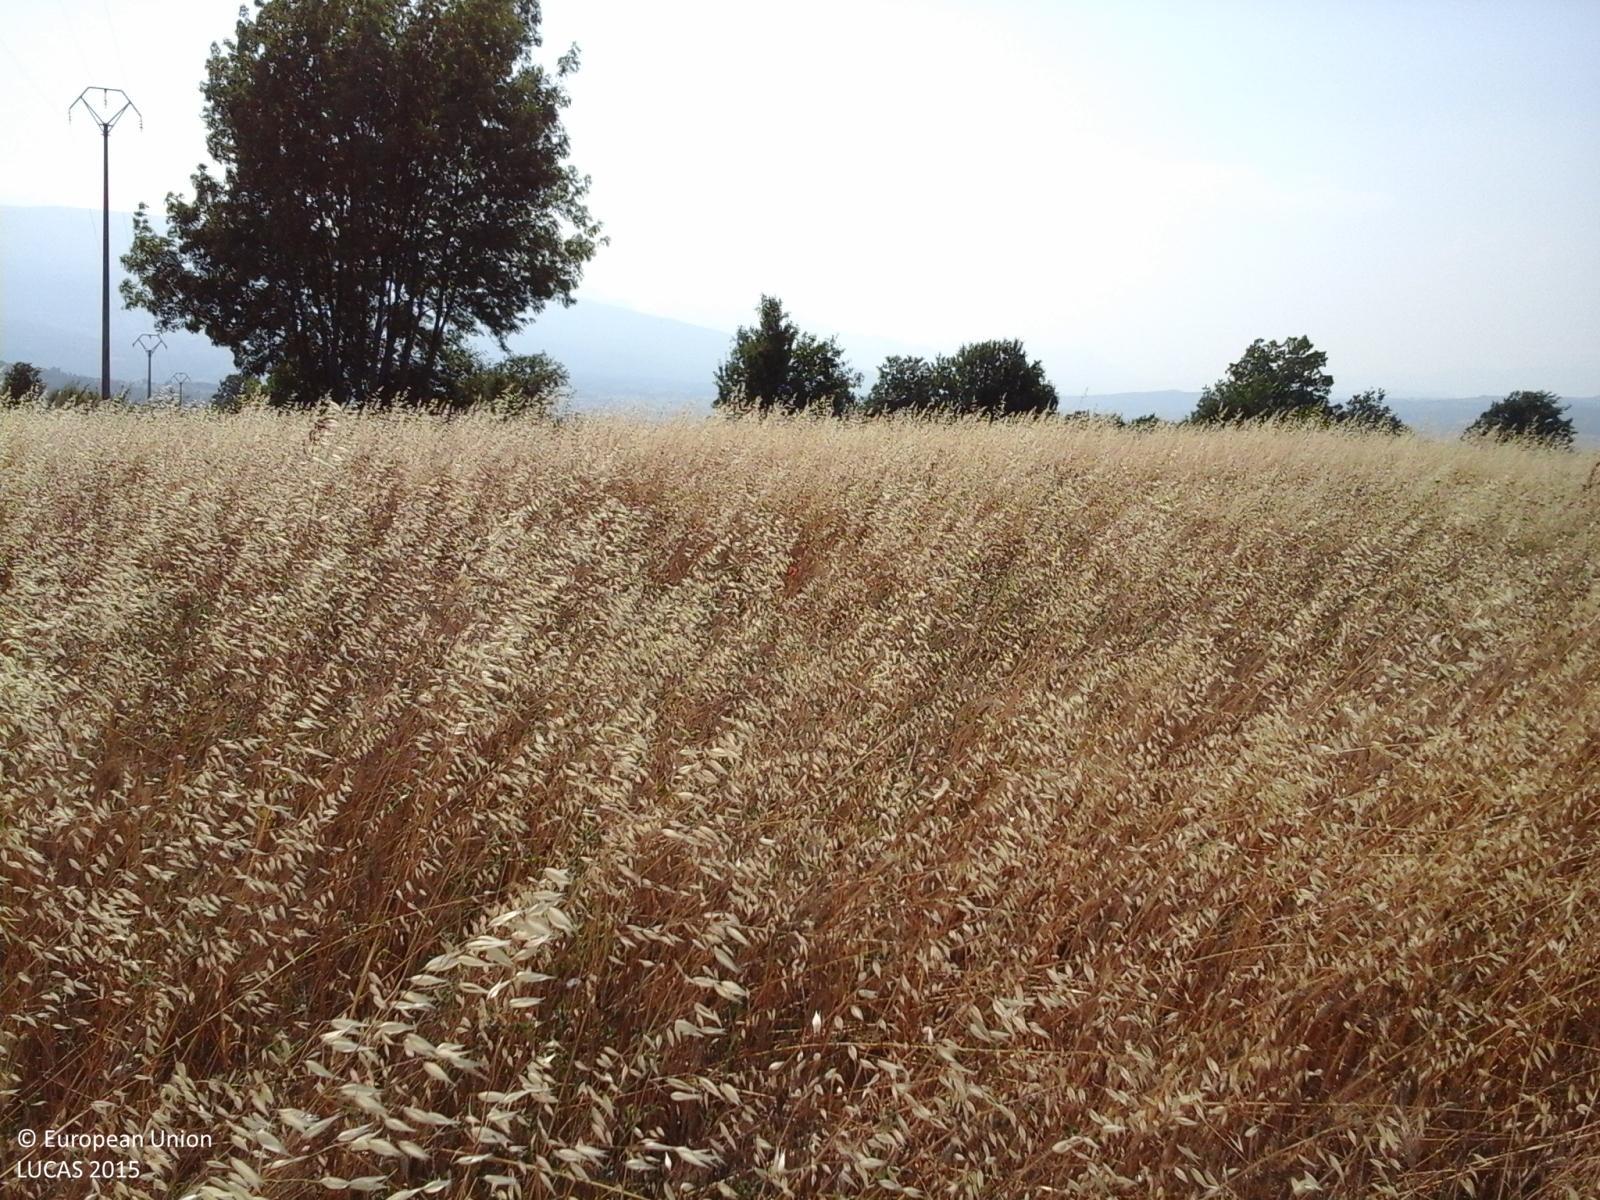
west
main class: Cropland
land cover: Durum wheat
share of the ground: > 75 %
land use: Agriculture (excluding fallow land and kitchen gardens)
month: July
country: IT
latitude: 41.4225
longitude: 14.7094
